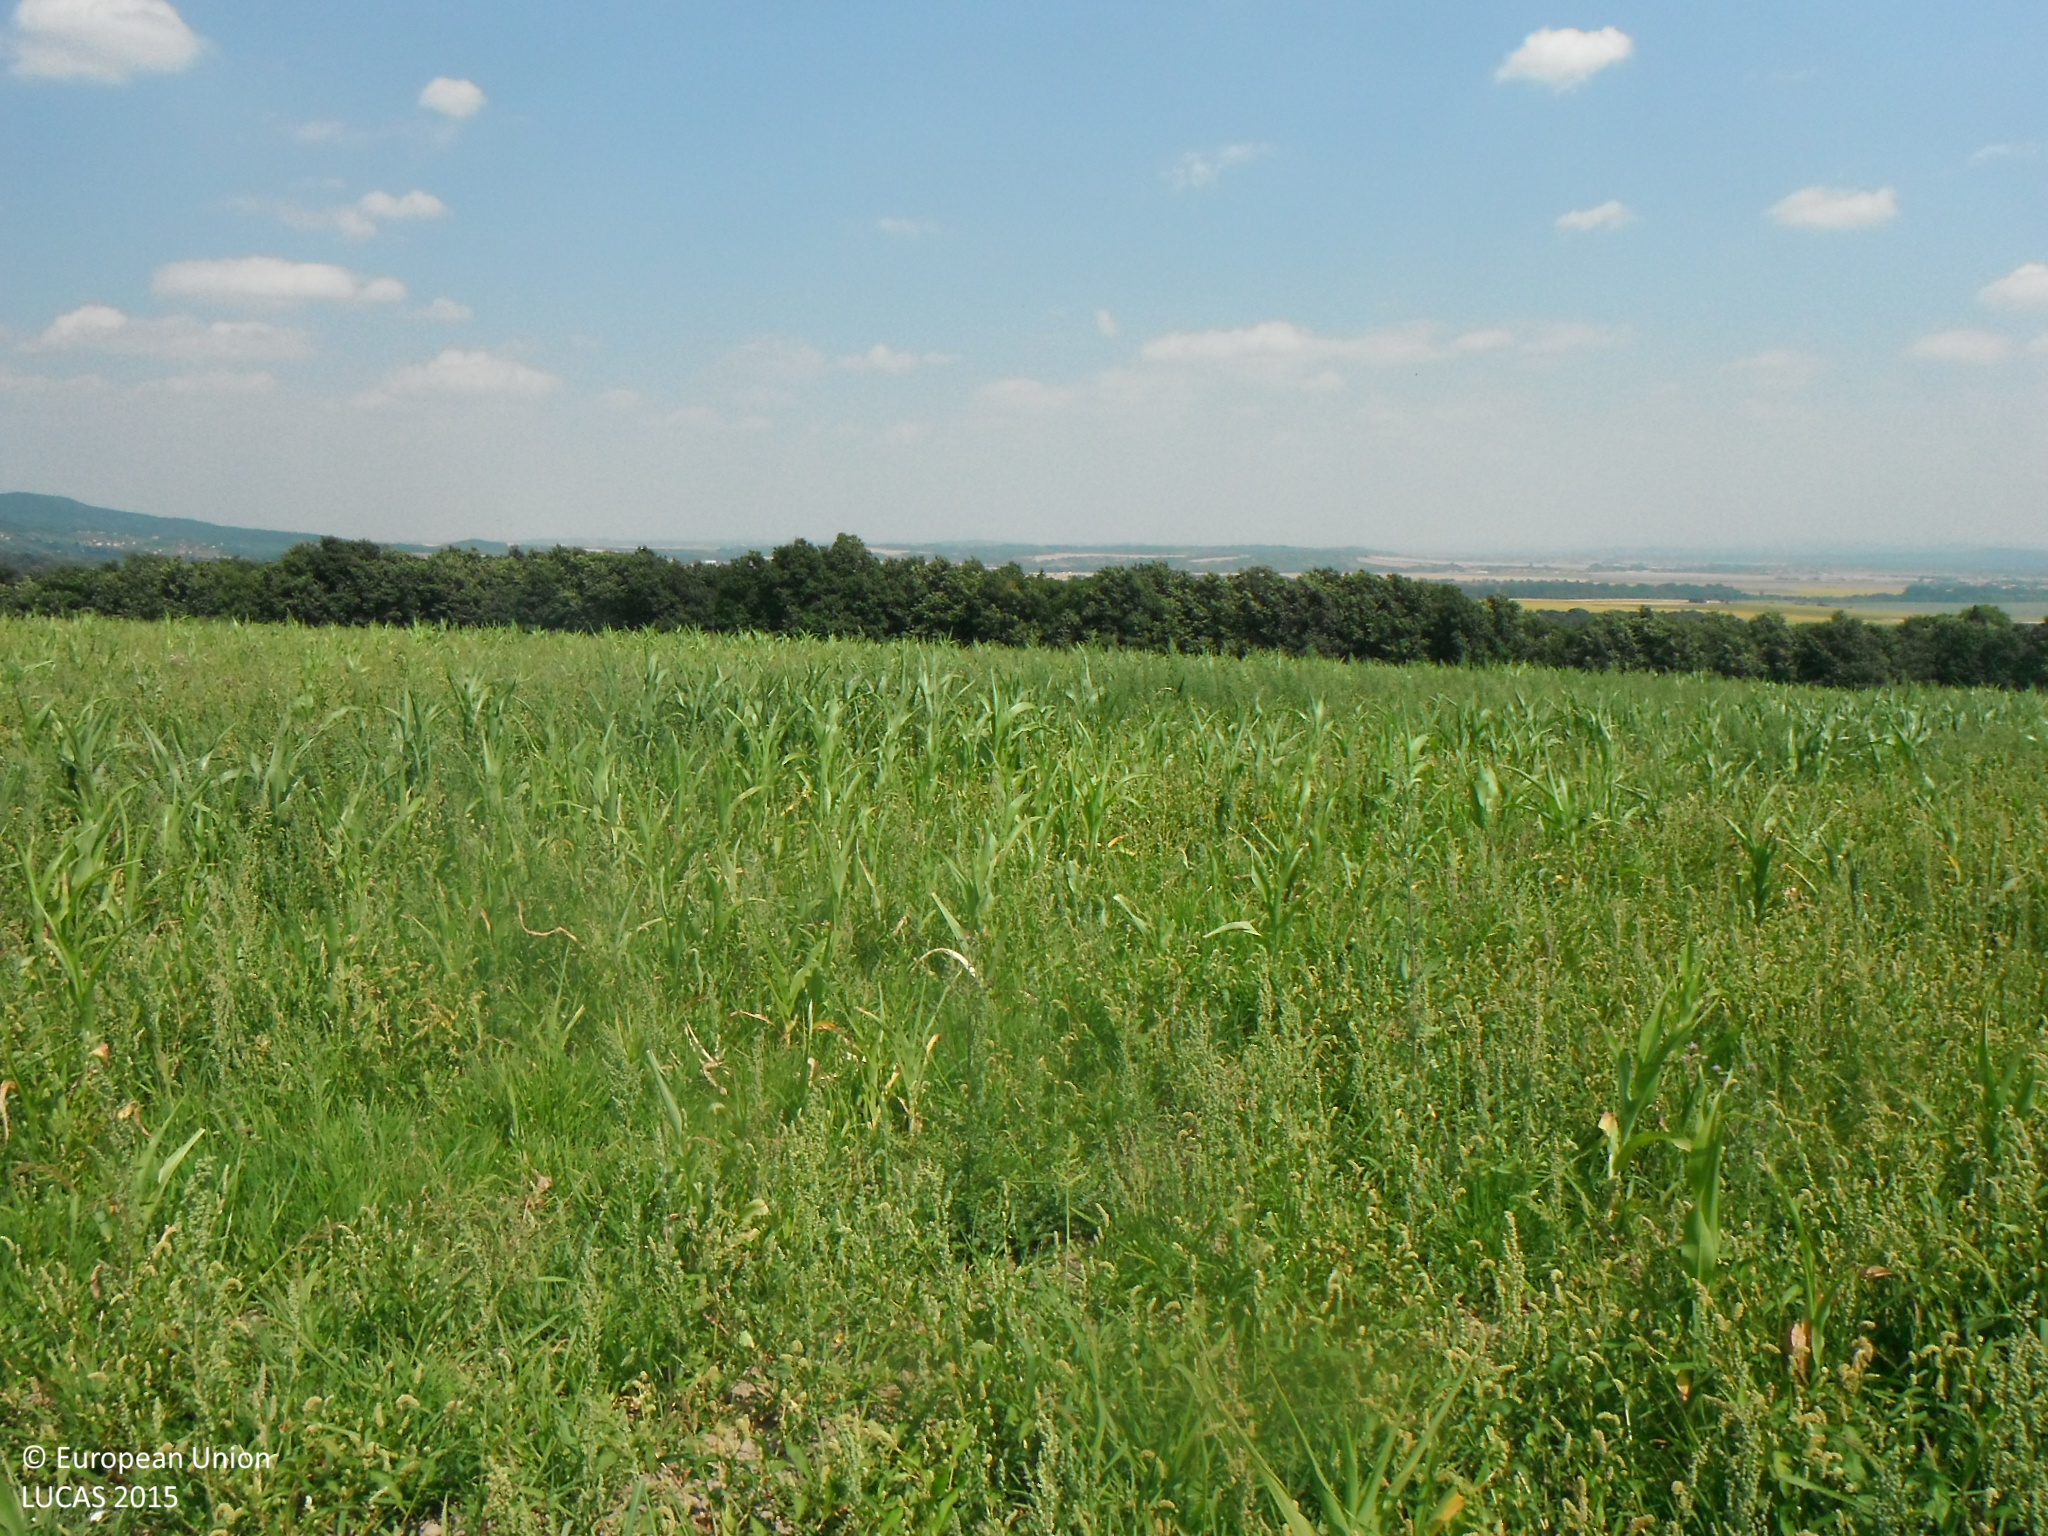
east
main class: Cropland
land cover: Maize
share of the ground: 25 - 50 %
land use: Agriculture (excluding fallow land and kitchen gardens)
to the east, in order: Maize; Tracks; Broadleaved woodland; Tracks; Broadleaved woodland
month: July
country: SK
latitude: 48.1035
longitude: 19.0579
